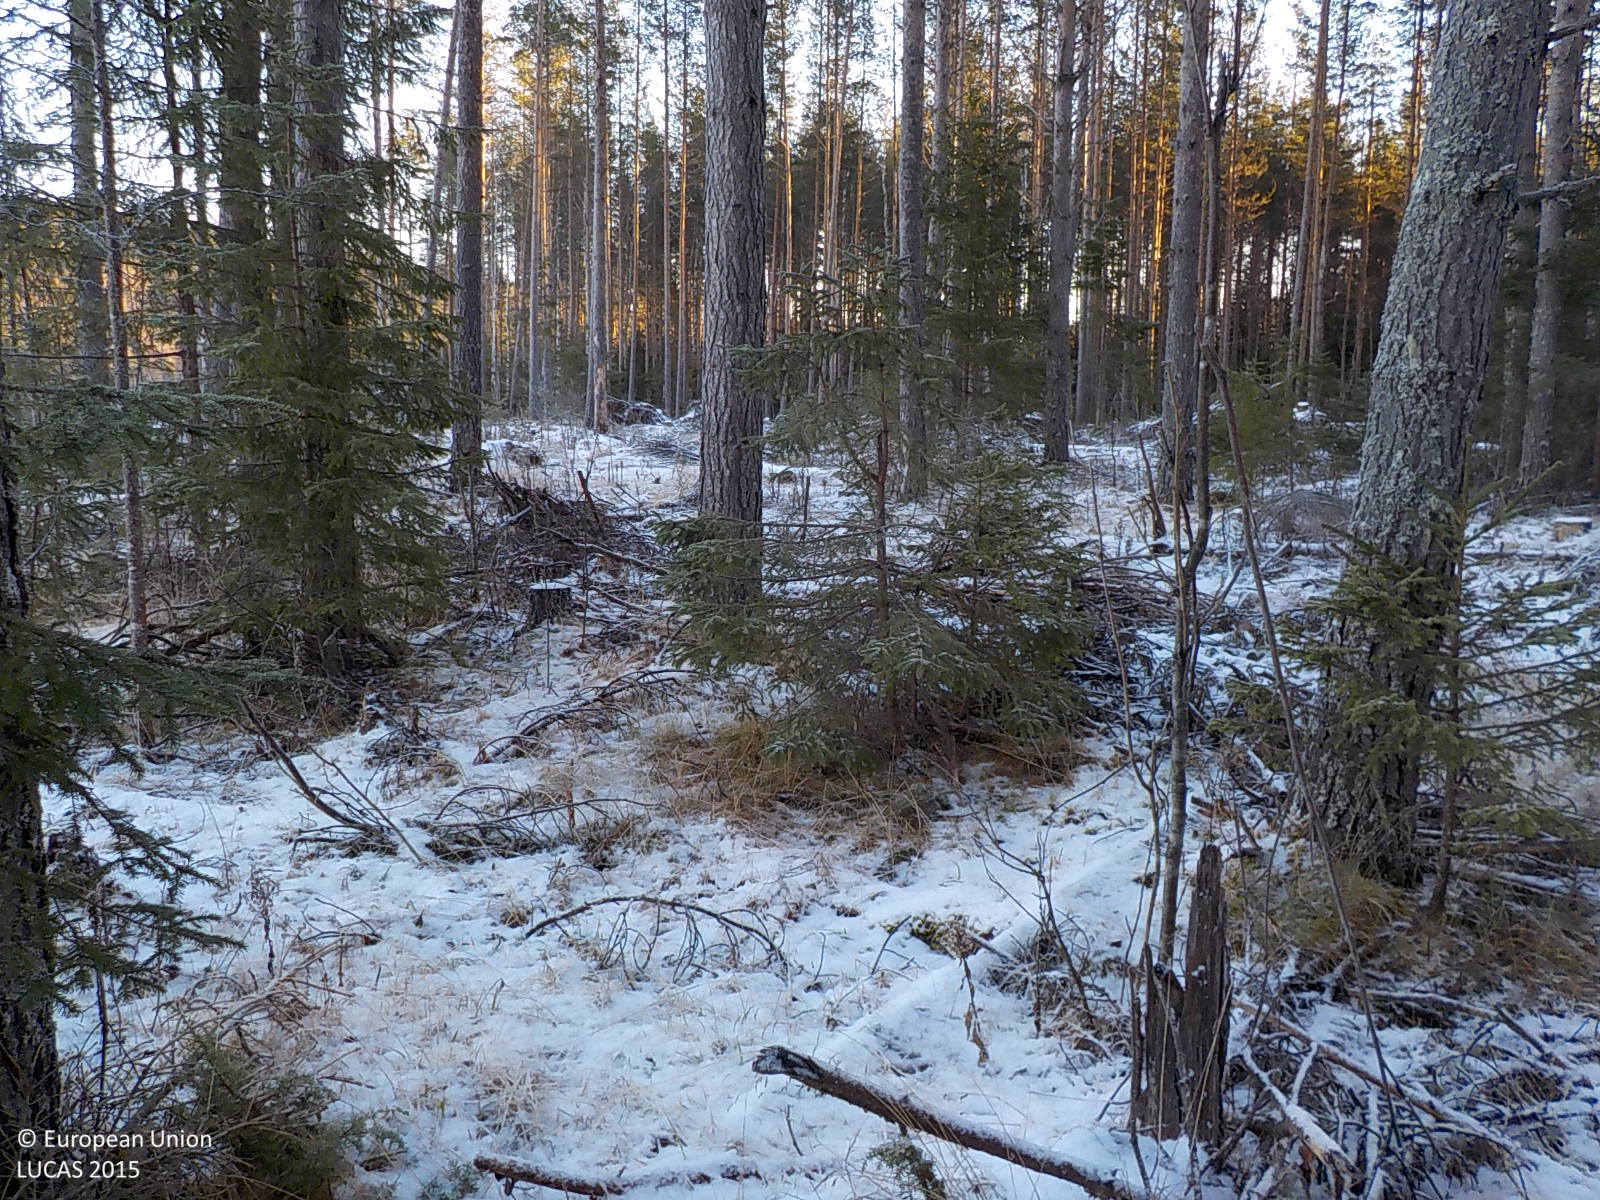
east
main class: Woodland
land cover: Pine dominated coniferous woodland
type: boreal forest
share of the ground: > 75 %
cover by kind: coniferous forest trees 75 %, shrubs 10 %, herbaceous plants 10 %, lichens and mosses 5 %
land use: Forestry
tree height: > 5 m
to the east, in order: Tracks; Pine dominated coniferous woodland; Ditches and canals; Pine dominated coniferous woodland; Electric lines
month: December
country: SE
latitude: 63.2981
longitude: 16.6572
